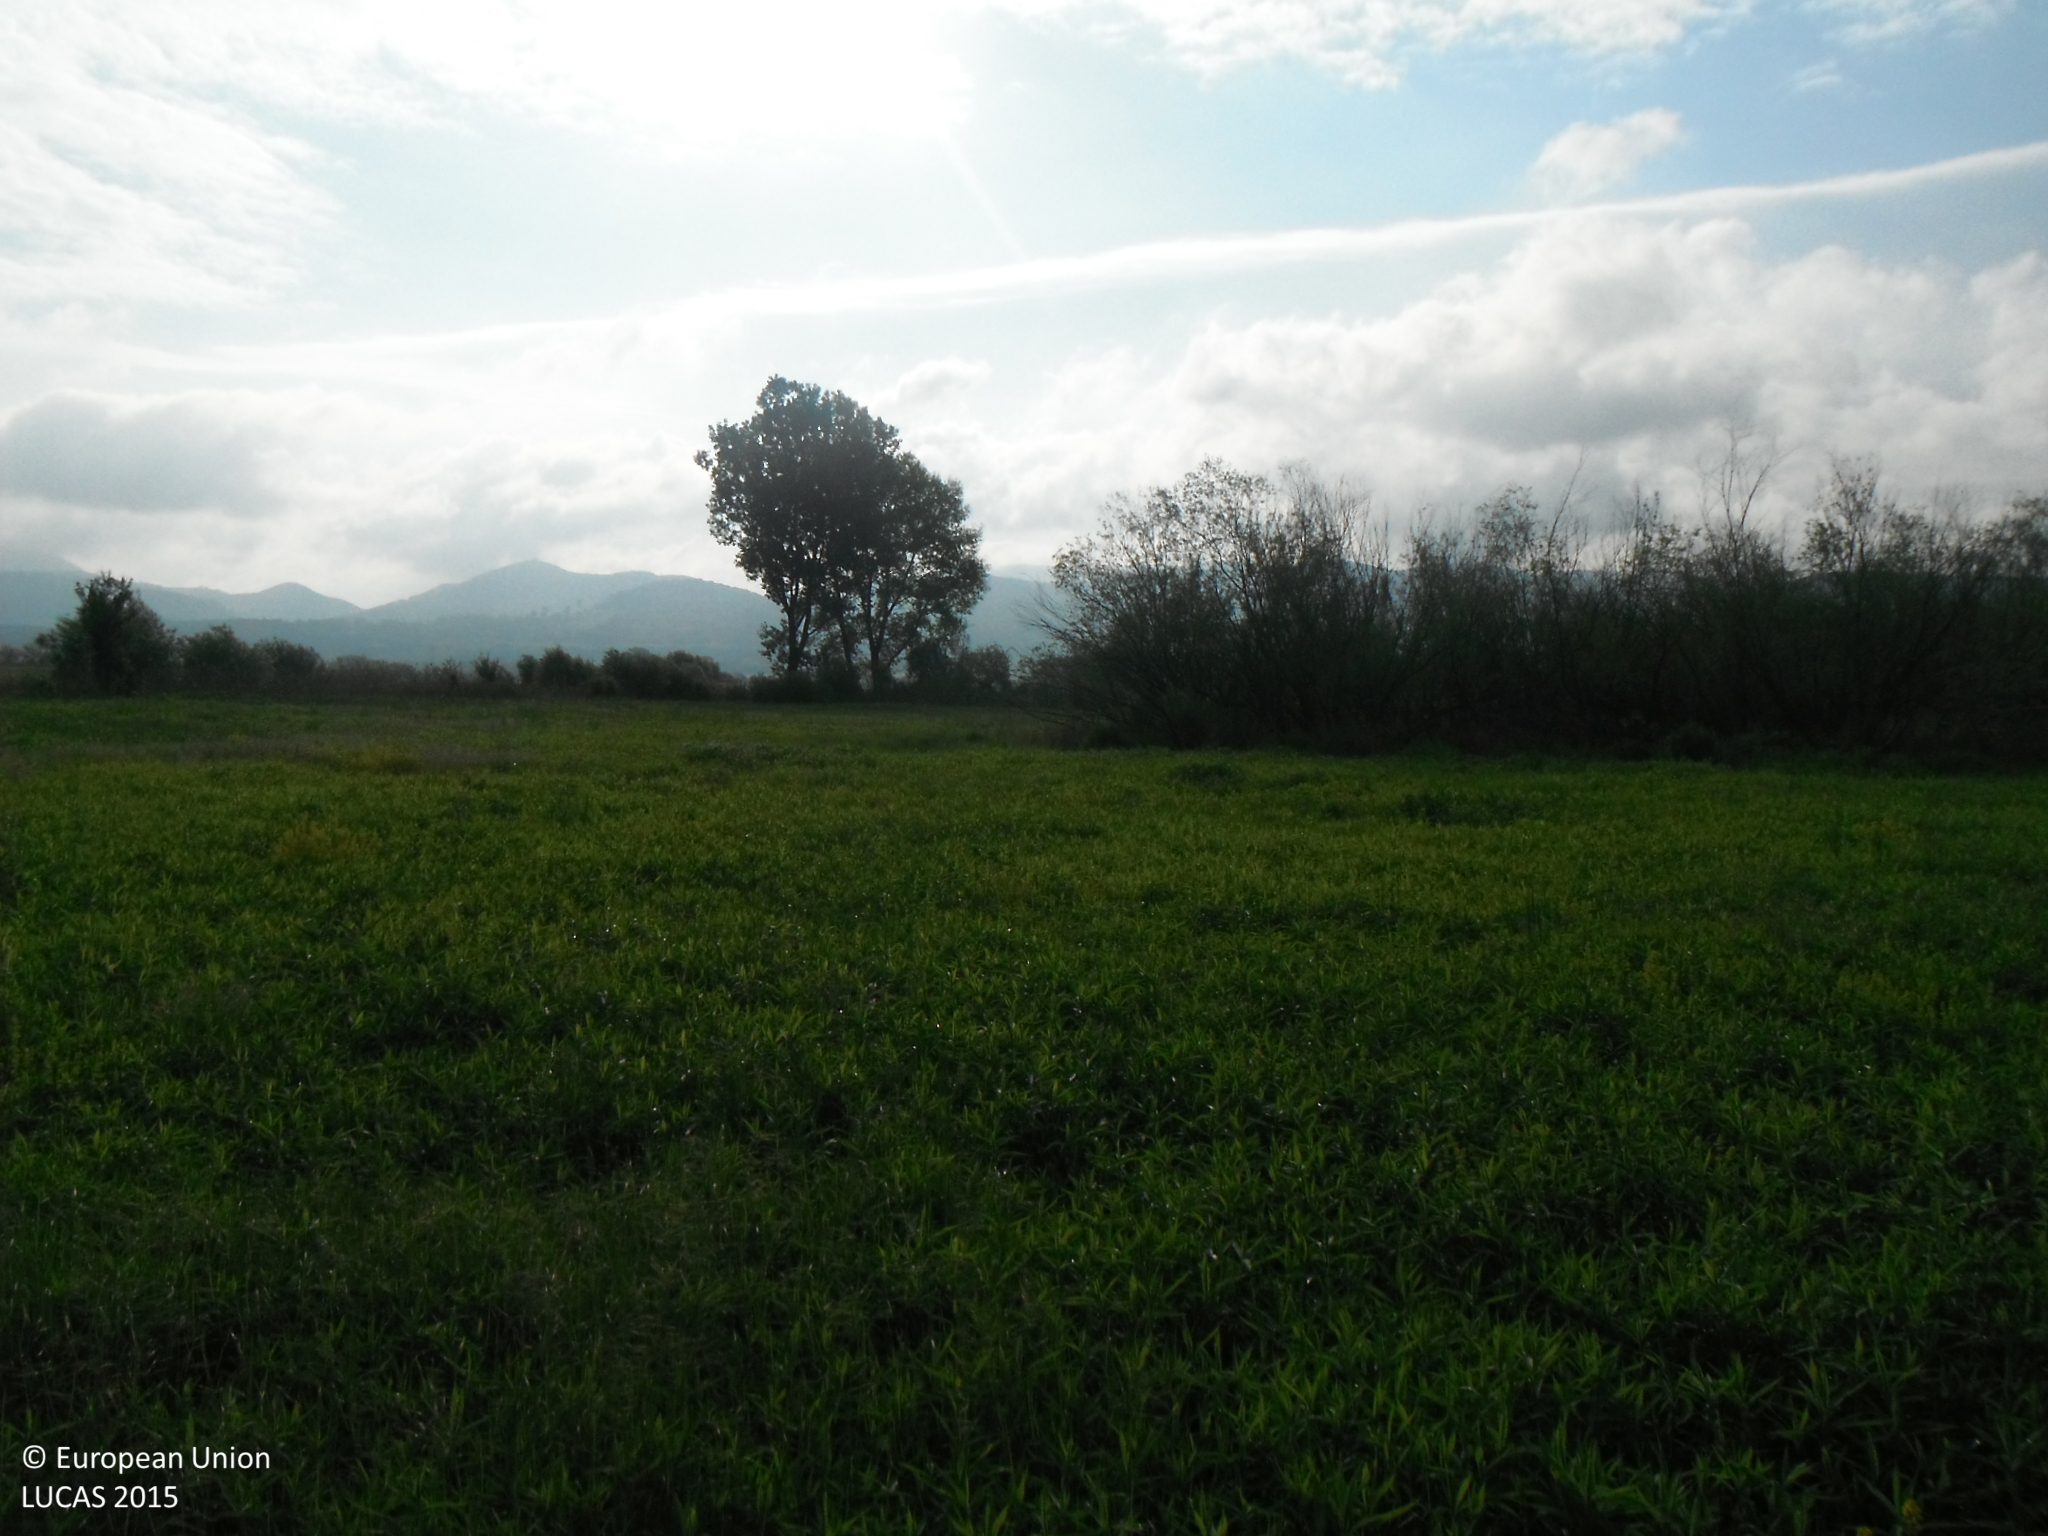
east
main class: Grassland
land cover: Spontaneously vegetated surfaces
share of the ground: > 75 %
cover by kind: herbaceous plants 100 %
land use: Semi-natural and natural areas not in use
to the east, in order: Spontaneously vegetated surfaces; Single bushes/trees; Ditches and canals; Shrubland with sparse tree cover; Spontaneously vegetated surfaces; Common wheat
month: May
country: SK
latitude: 48.3902
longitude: 17.1254
